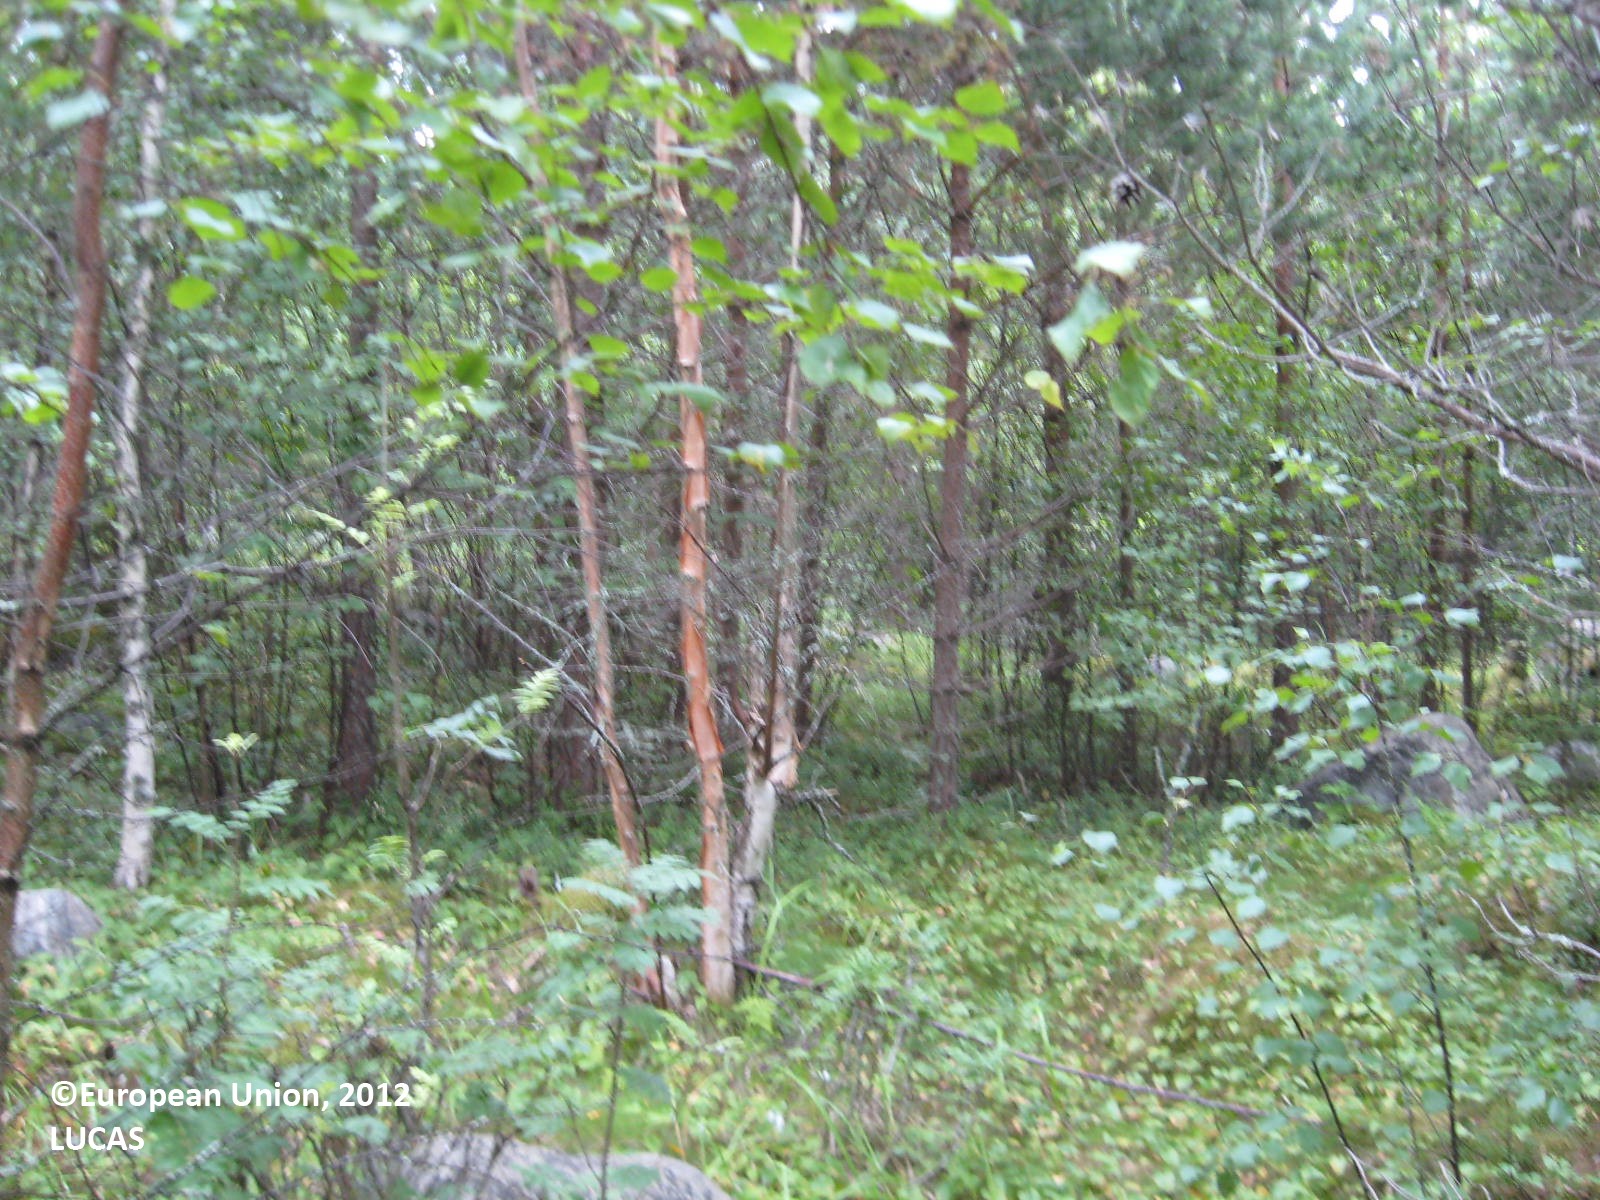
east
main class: Woodland
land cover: Other mixed woodland
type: boreal forest
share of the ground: > 75 %
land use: Forestry
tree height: > 5 m
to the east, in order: Other mixed woodland; Pine dominated coniferous woodland; Inland marshes; Other coniferous woodland
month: July
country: FI
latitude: 61.8800
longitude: 21.4780
